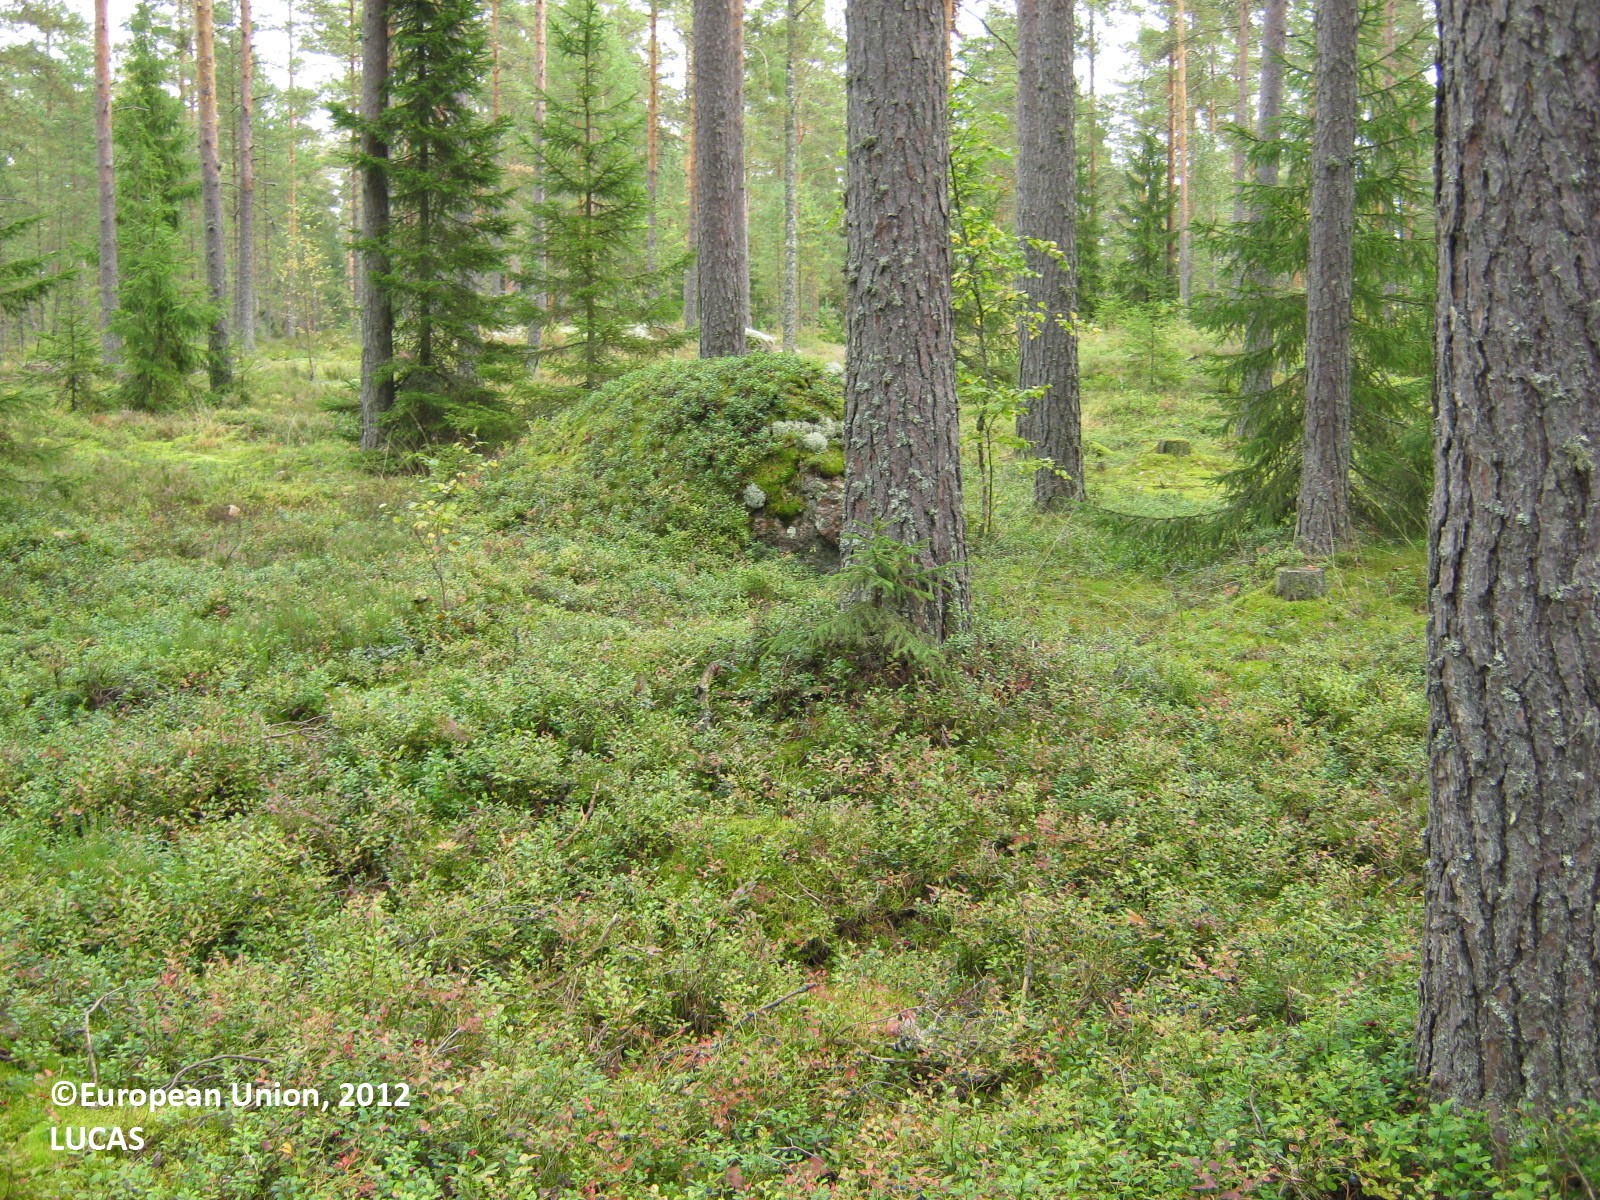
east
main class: Woodland
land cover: Other coniferous woodland
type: boreal forest
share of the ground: 50 - 75 %
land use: Forestry
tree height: > 5 m
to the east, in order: Other coniferous woodland; Spruce dominated coniferous woodland
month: September
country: FI
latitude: 60.6415
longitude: 27.6906
